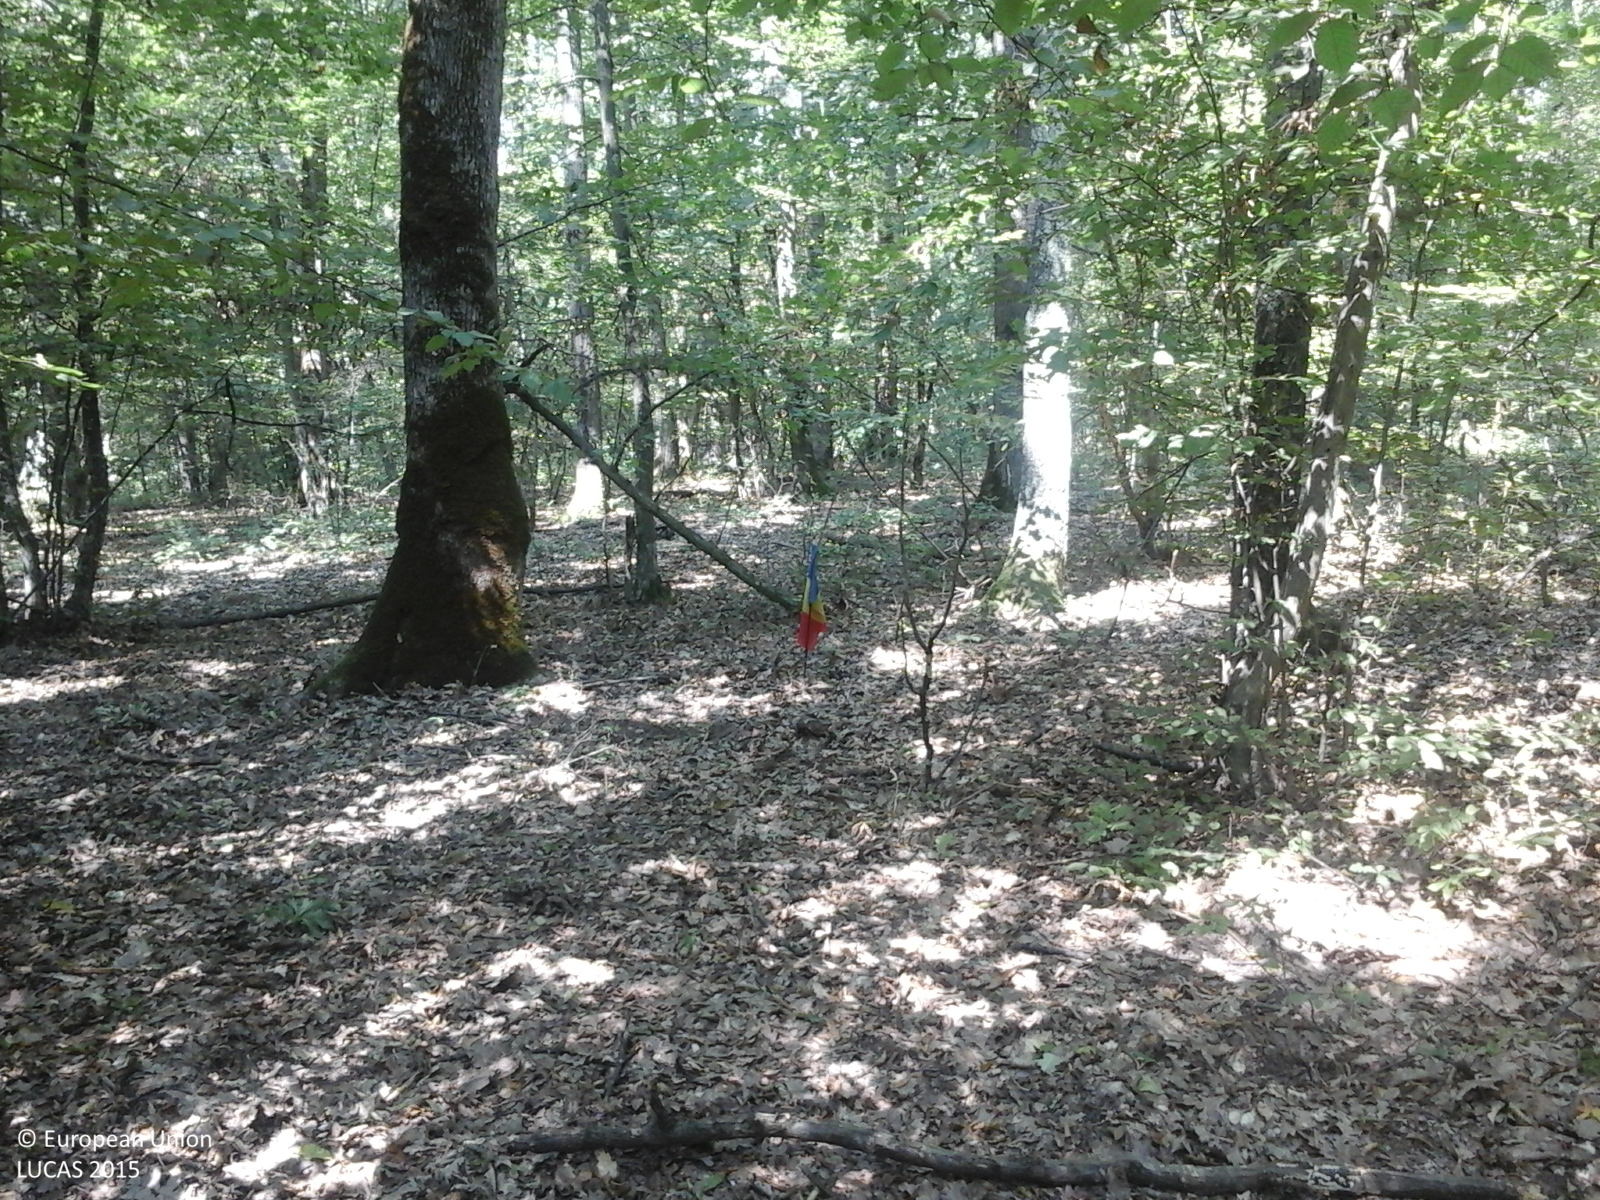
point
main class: Woodland
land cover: Broadleaved woodland
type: beech forest
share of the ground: > 75 %
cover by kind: broadleaved forest trees 100 %
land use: Forestry
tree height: > 5 m
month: August
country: RO
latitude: 46.3715
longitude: 21.9375
